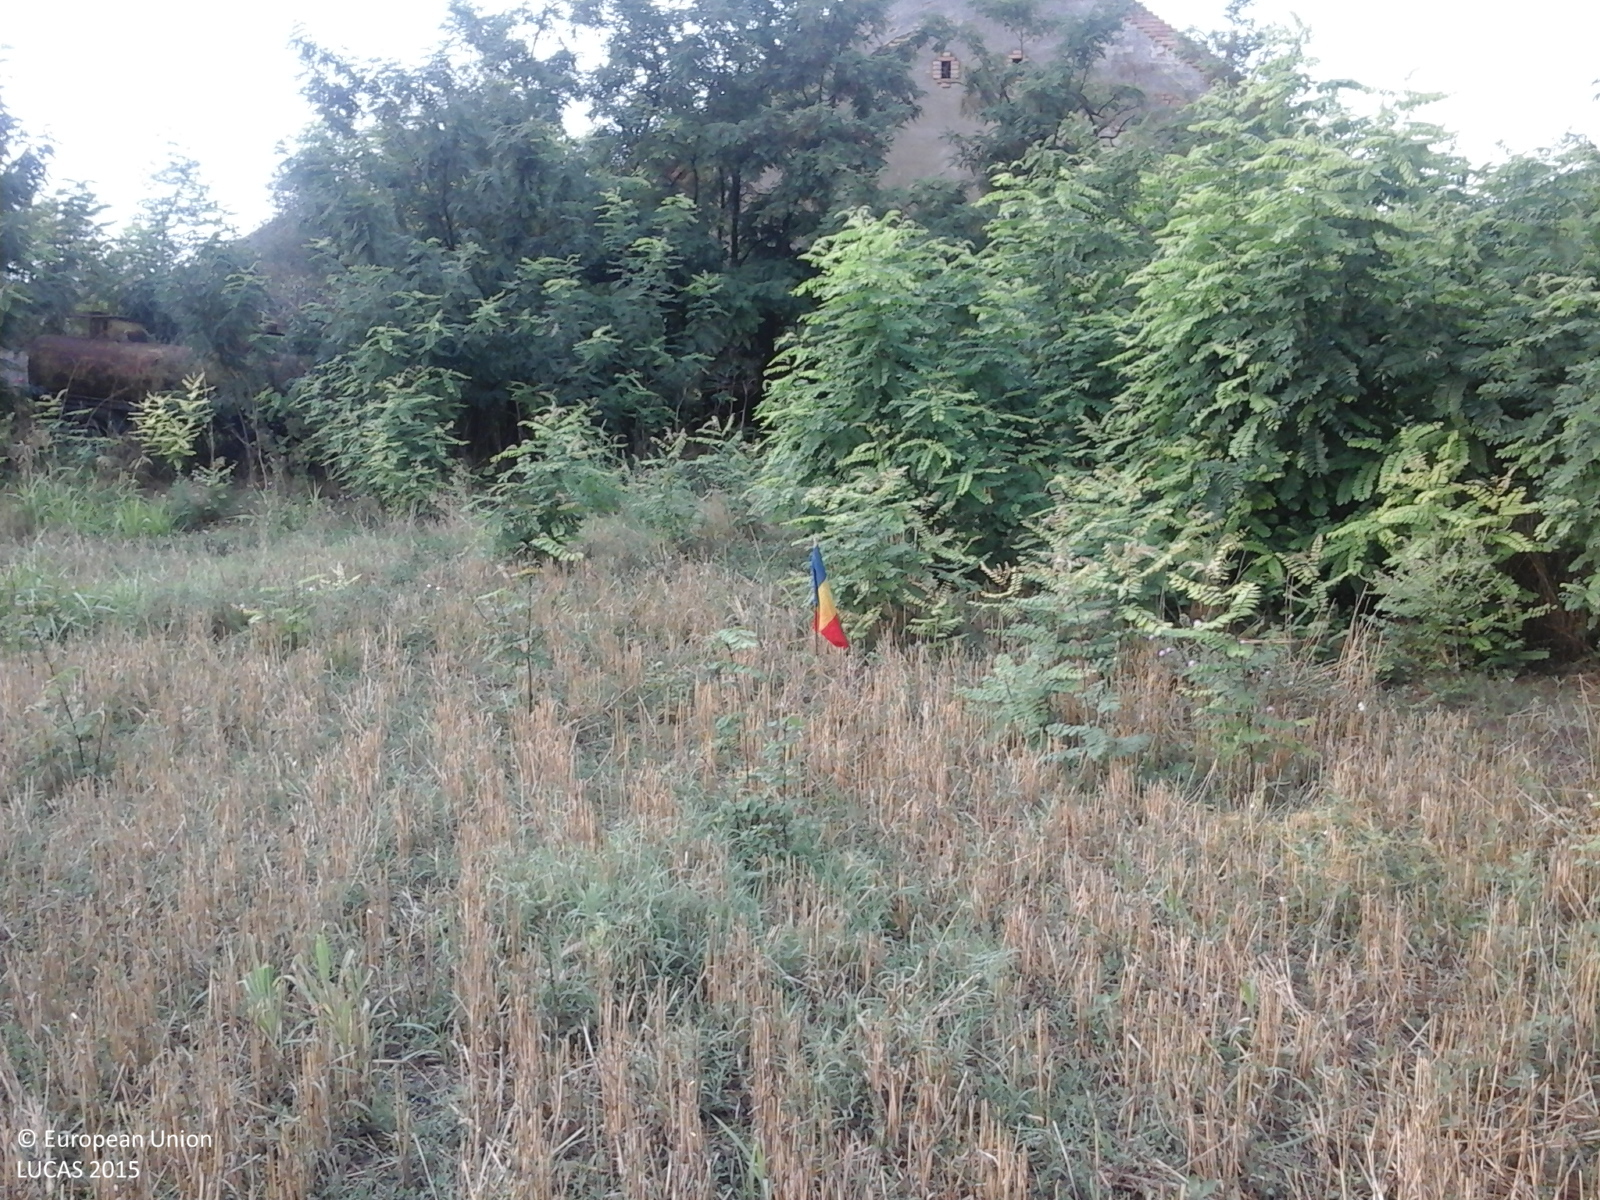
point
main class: Grassland
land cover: Grassland with sparse tree/shrub cover
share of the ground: > 75 %
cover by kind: herbaceous plants 90 %, broadleaved forest trees 5 %, shrubs 5 %
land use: Agriculture (excluding fallow land and kitchen gardens)
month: August
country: RO
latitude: 45.9100
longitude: 20.8171
